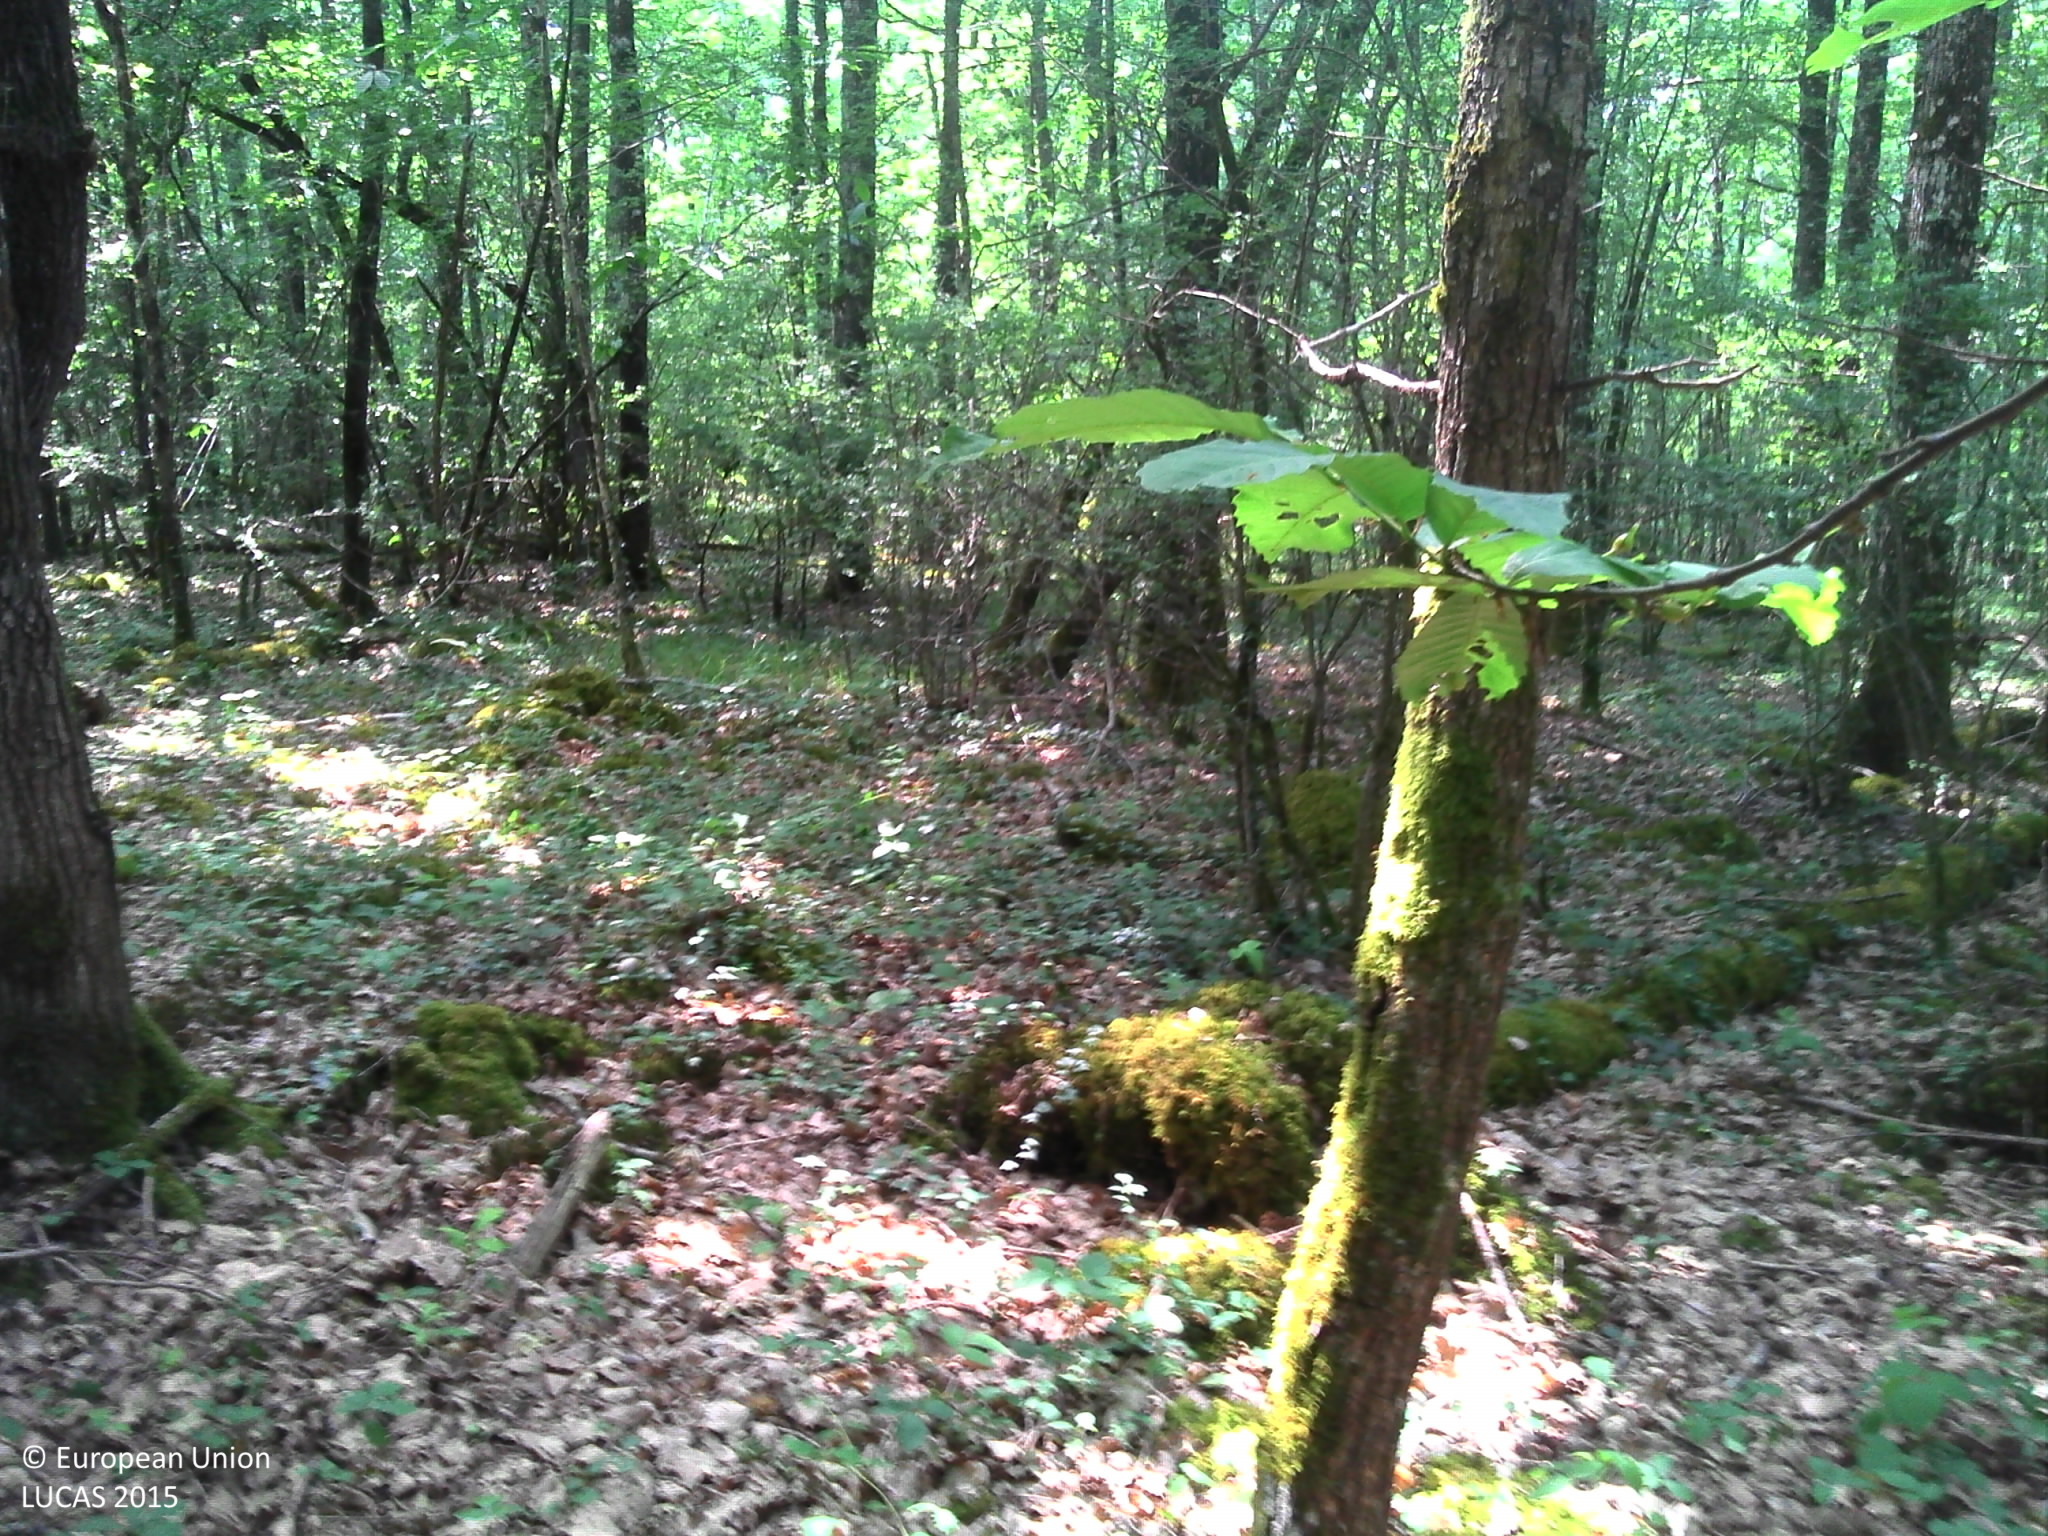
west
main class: Woodland
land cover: Broadleaved woodland
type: mesophytic deciduous forest
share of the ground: > 75 %
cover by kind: broadleaved forest trees 85 %, herbaceous plants 10 %, coniferous forest trees 5 %
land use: Forestry
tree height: > 5 m
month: June
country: FR
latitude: 47.6285
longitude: 0.6775
